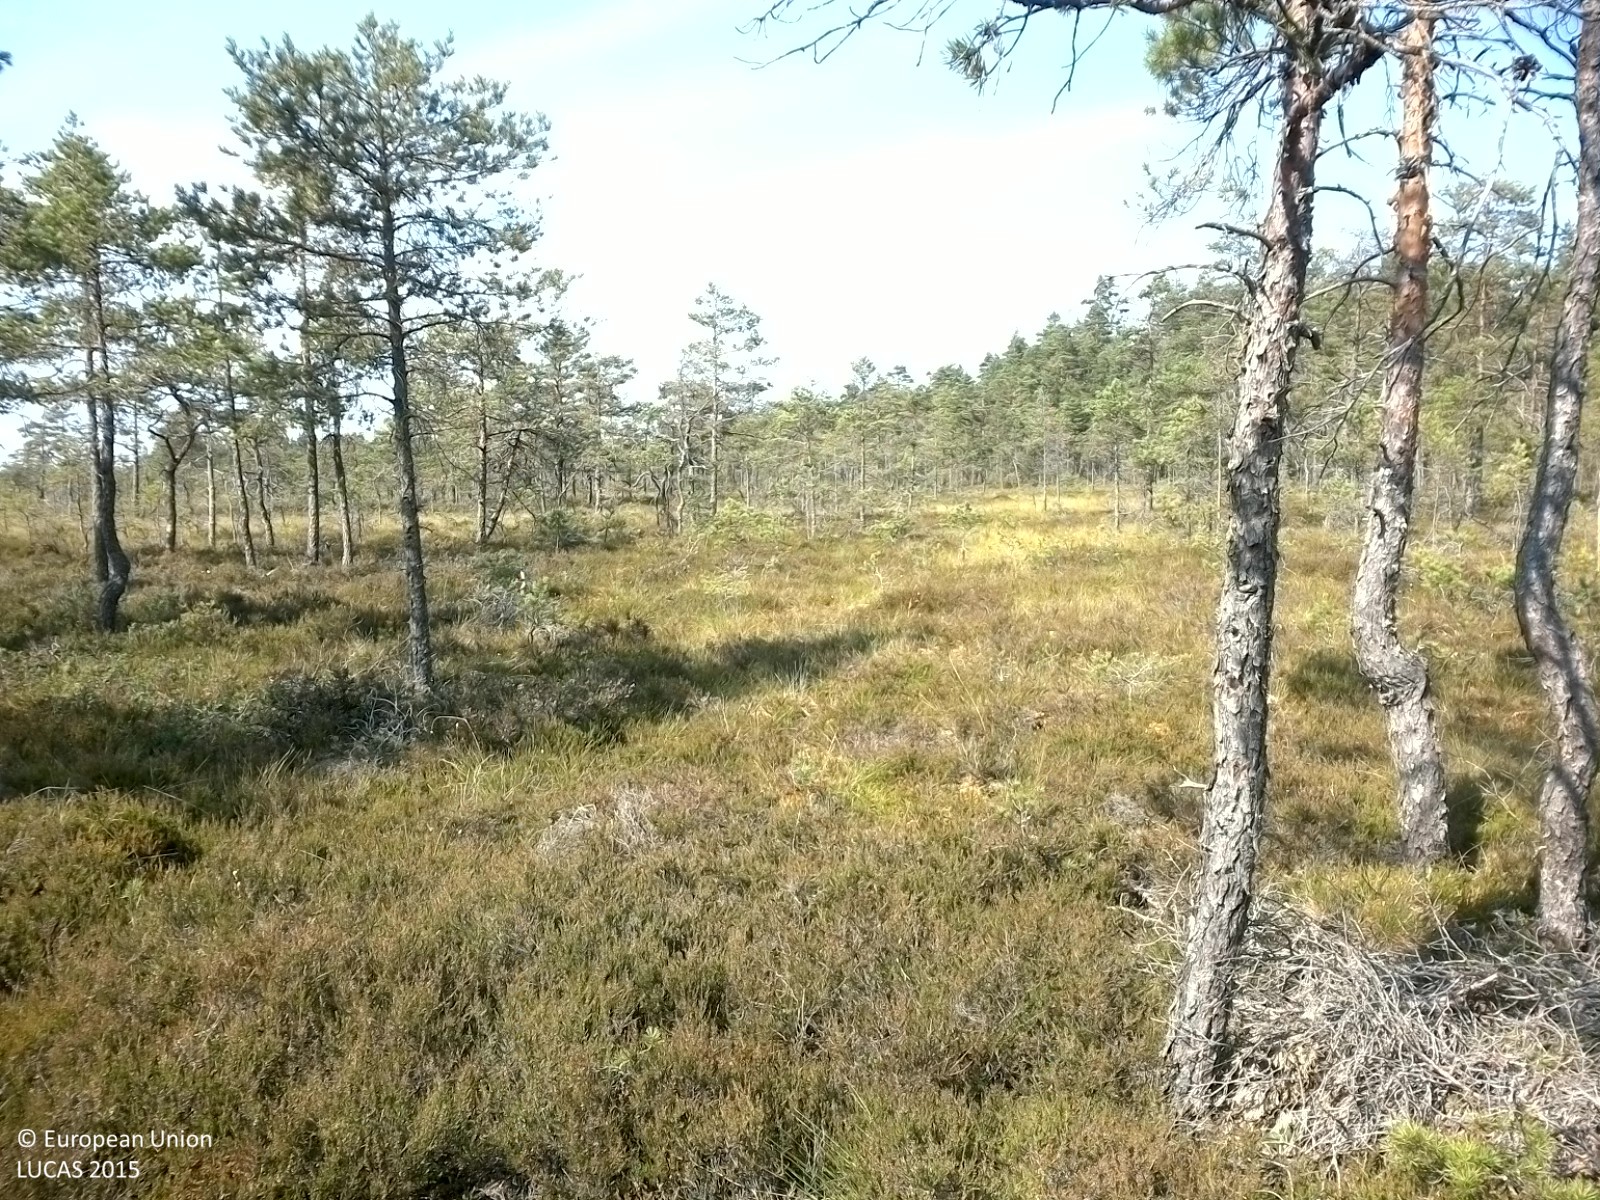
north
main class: Woodland
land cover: Pine dominated coniferous woodland
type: boreal forest
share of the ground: 10 - 25 %
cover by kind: shrubs 60 %, lichens and mosses 25 %, coniferous forest trees 15 %
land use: Semi-natural and natural areas not in use
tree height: < 5 m
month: August
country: SE
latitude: 59.0727
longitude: 14.7544
